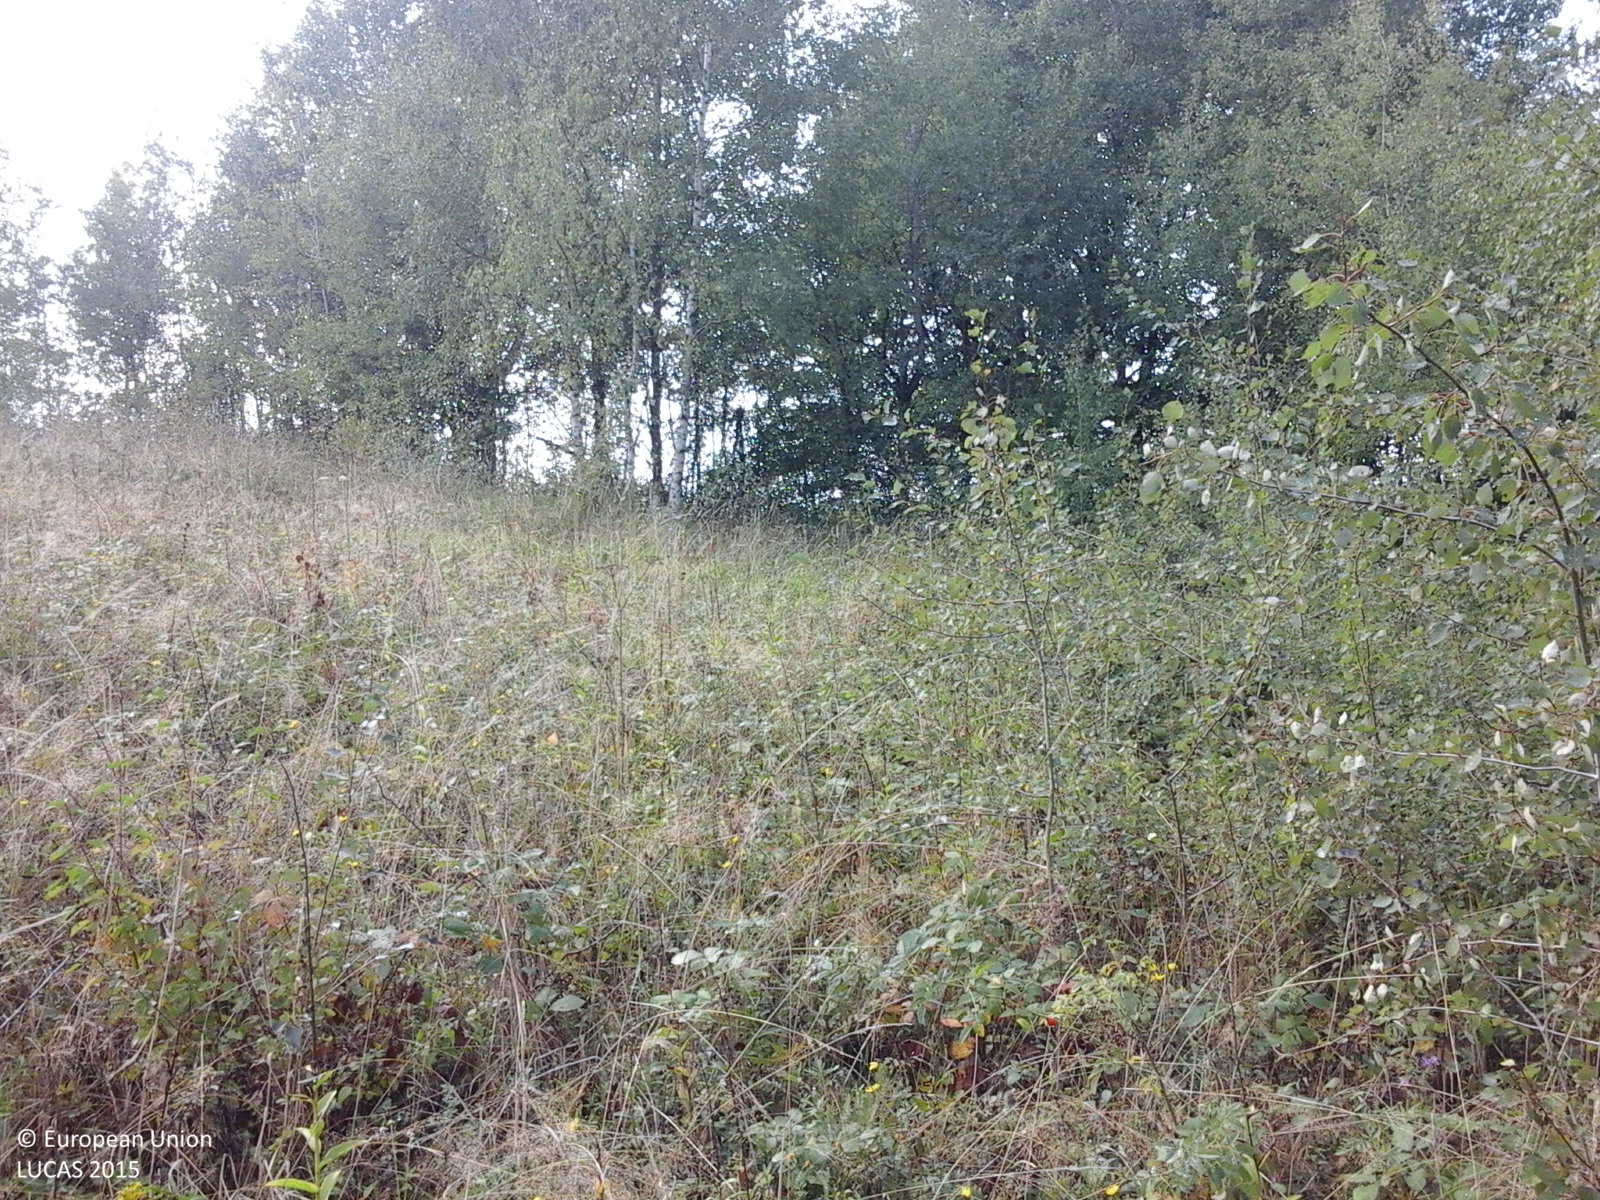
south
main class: Woodland
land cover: Broadleaved woodland
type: non-riverine alder, birch or aspen forest
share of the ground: > 75 %
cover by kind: broadleaved forest trees 100 %
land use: Forestry
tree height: > 5 m
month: September
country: RO
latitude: 45.4671
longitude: 22.0489
